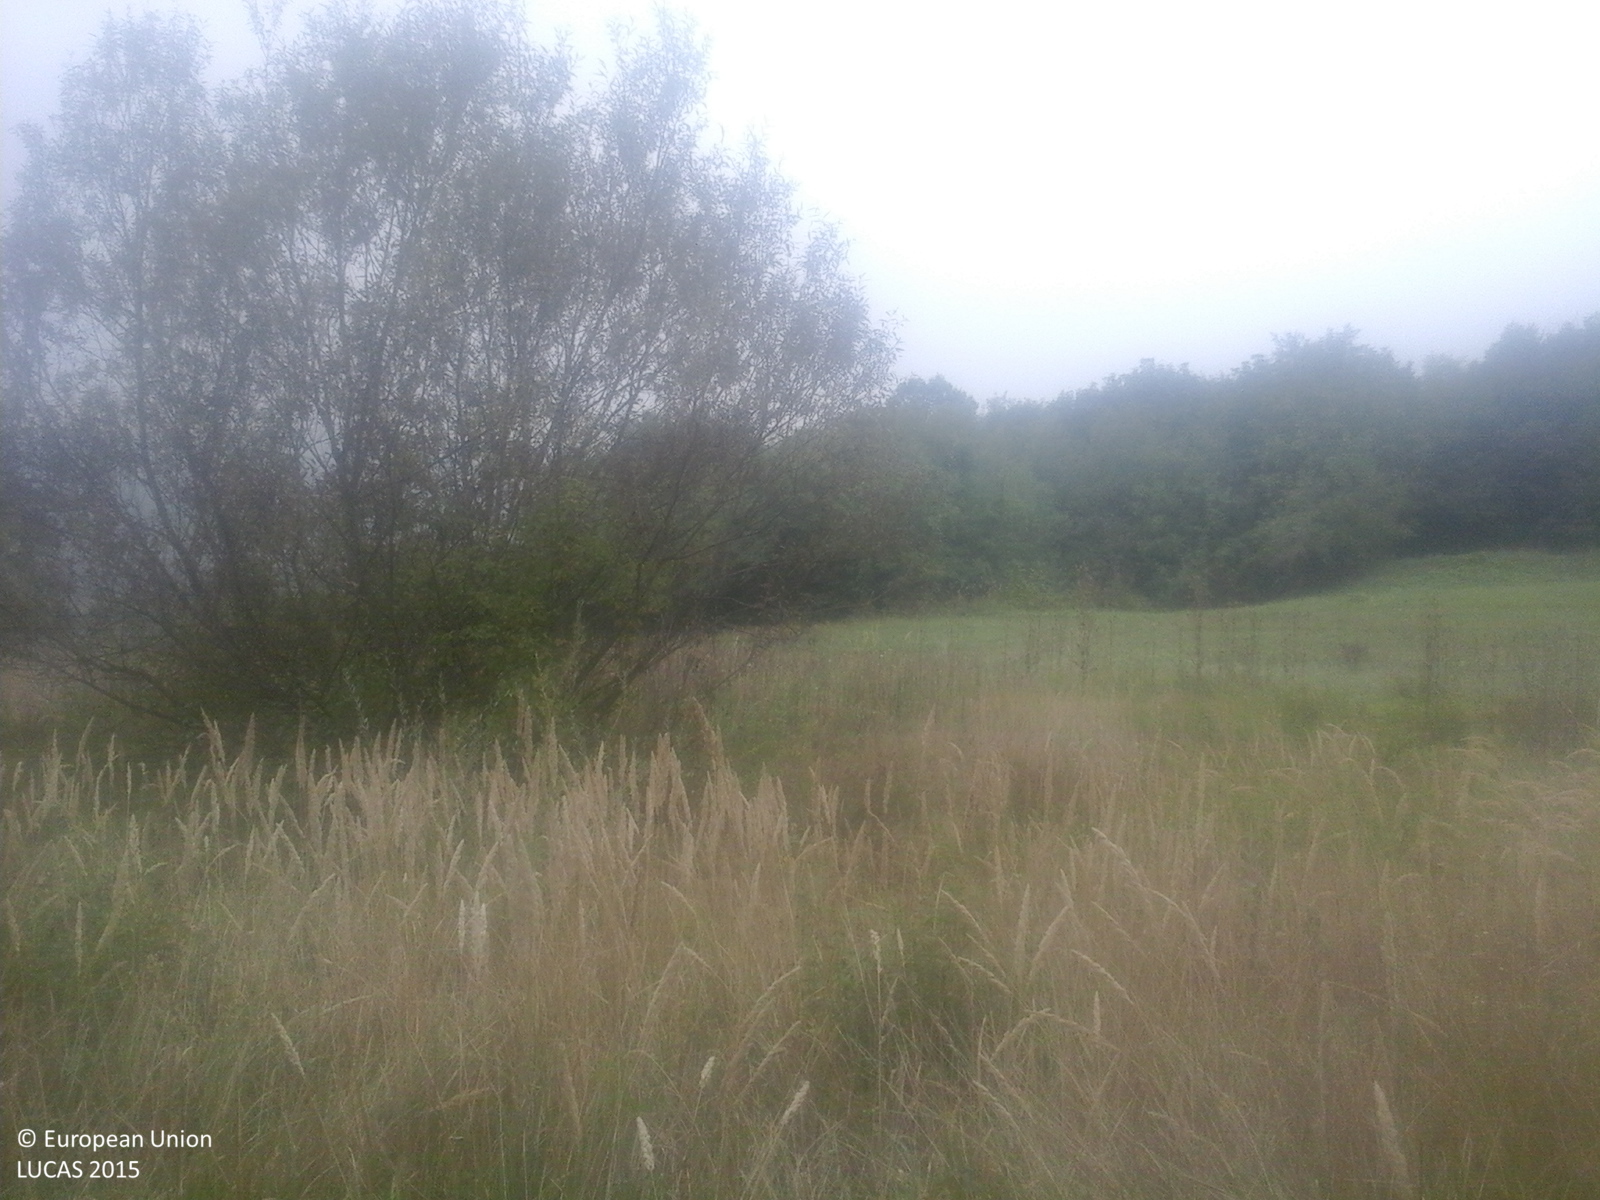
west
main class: Woodland
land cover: Broadleaved woodland
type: exotic forest
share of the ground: > 75 %
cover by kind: broadleaved forest trees 100 %
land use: Forestry
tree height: > 5 m
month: September
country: RO
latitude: 44.7832
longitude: 23.1817
